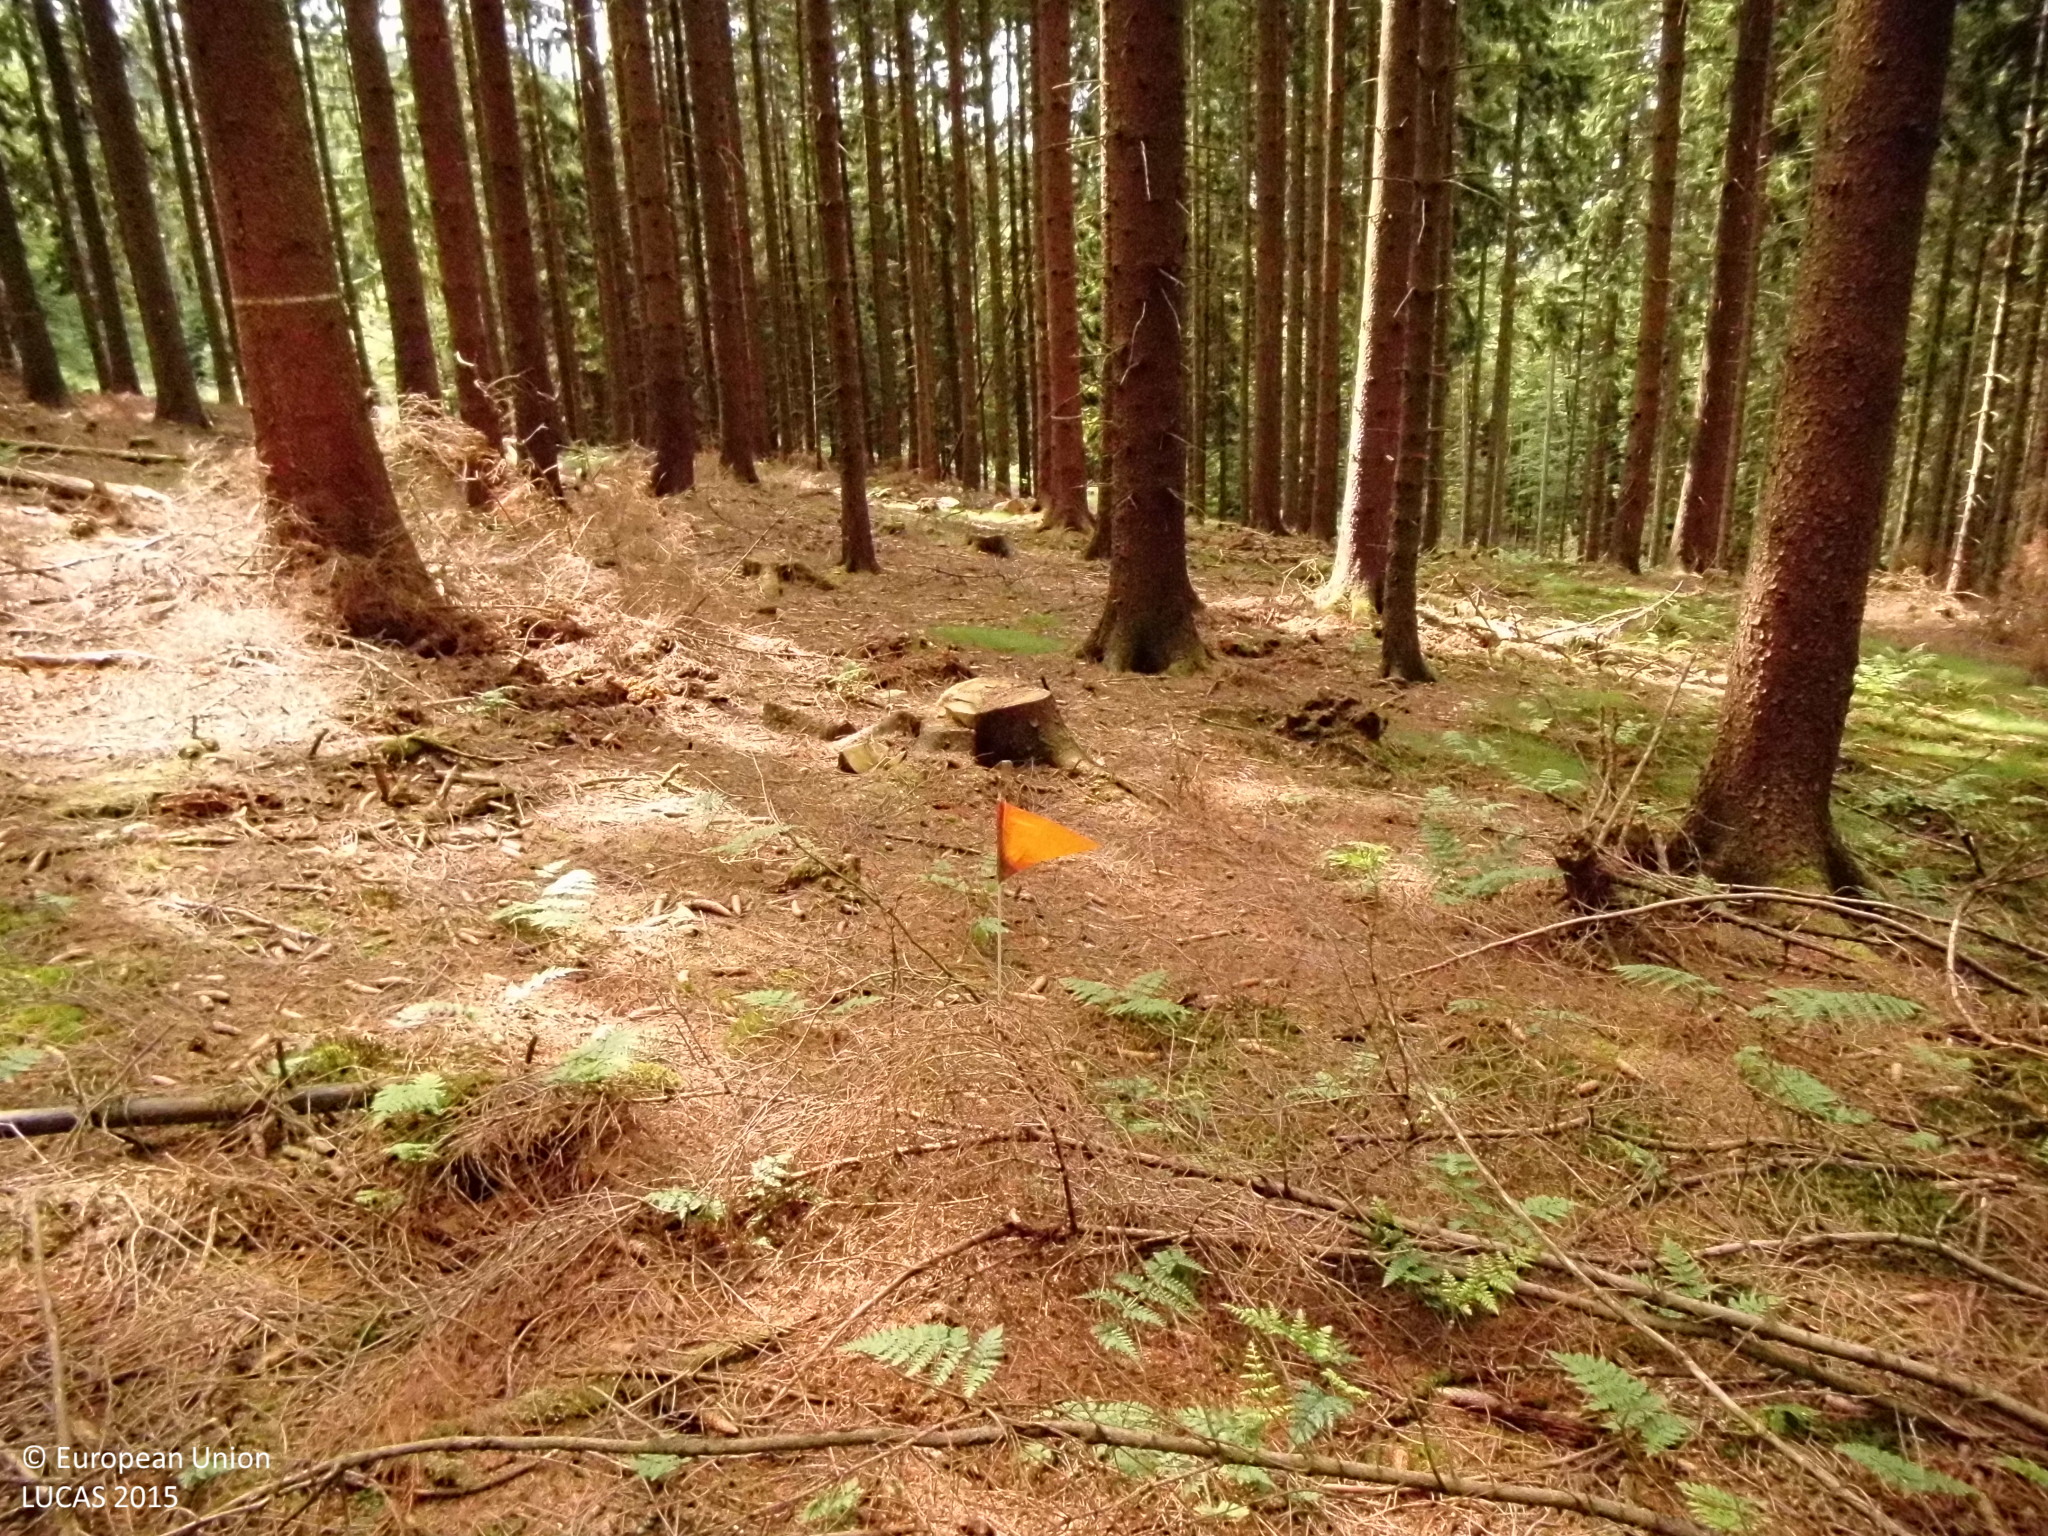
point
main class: Woodland
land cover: Spruce dominated coniferous woodland
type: hemiboreal forest and nemoral coniferous forest and mixed broadleaved-coniferous forest
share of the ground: > 75 %
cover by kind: coniferous forest trees 75 %, herbaceous plants 10 %, unconsolidated bare surface 10 %, lichens and mosses 5 %
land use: Forestry
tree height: > 5 m
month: July
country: DE
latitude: 50.7243
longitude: 8.0030
